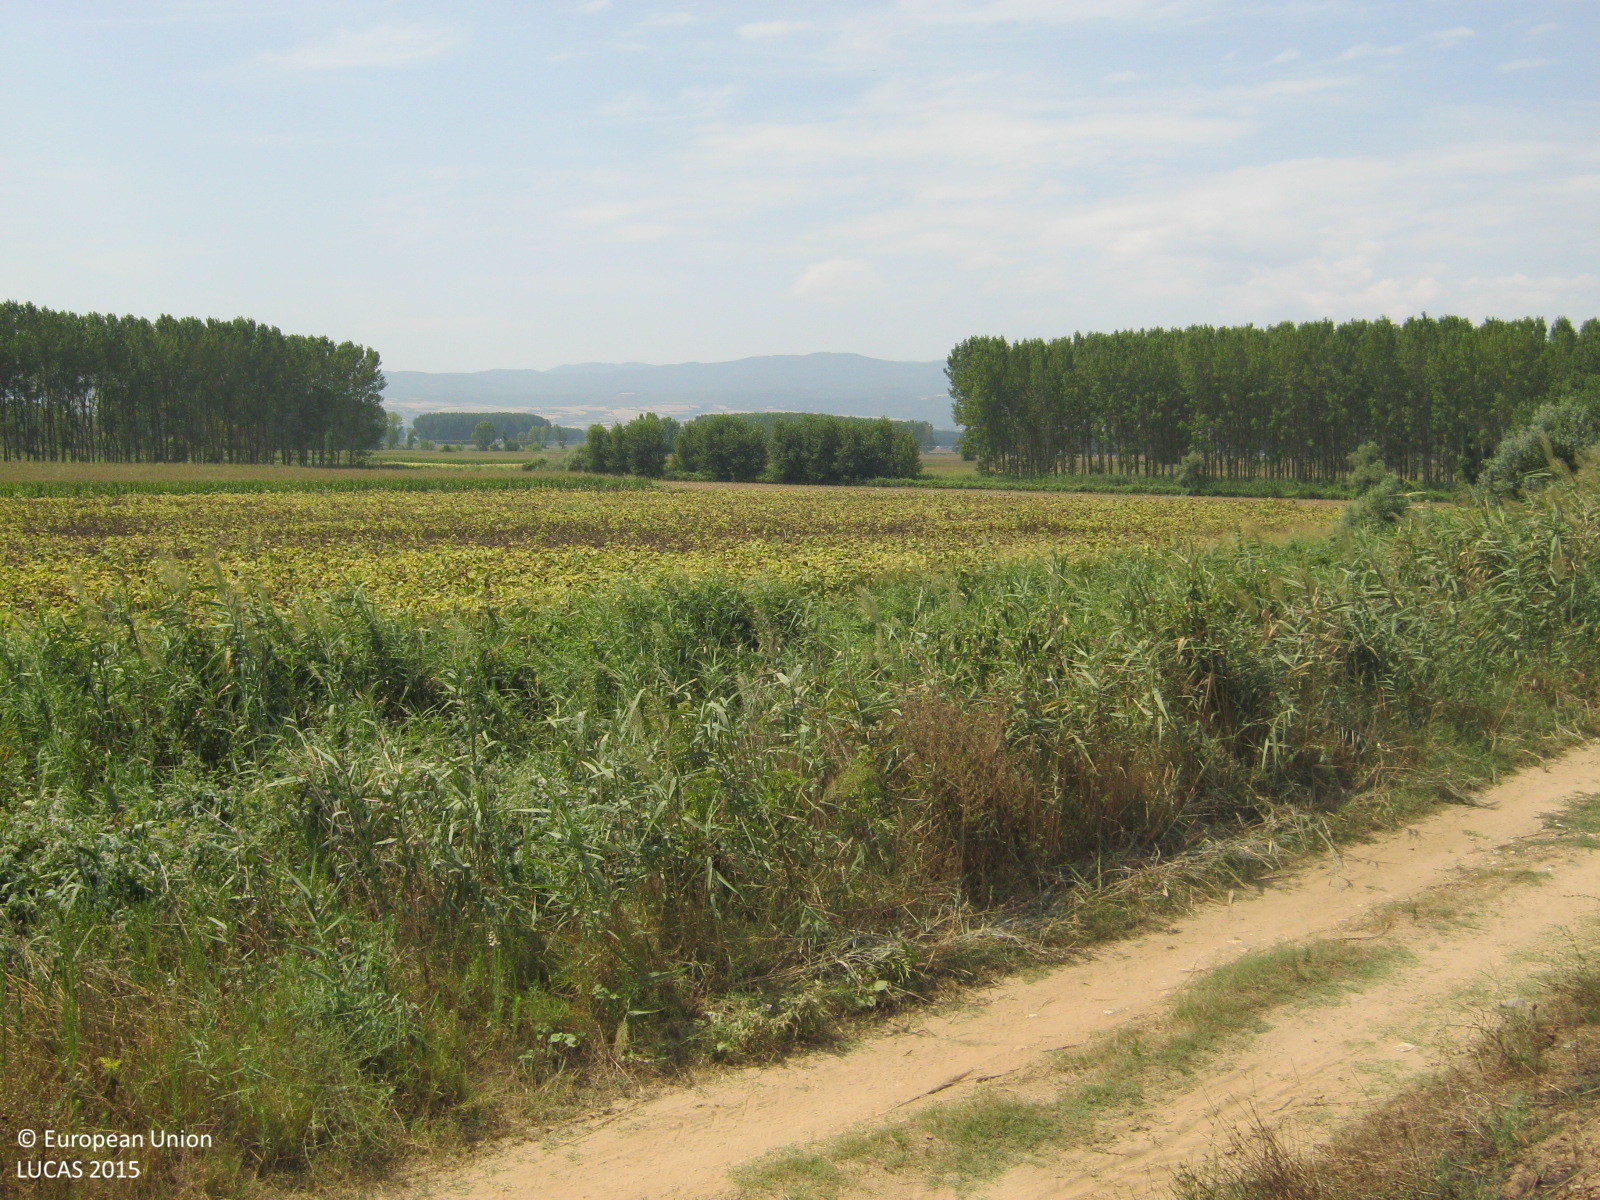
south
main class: Grassland
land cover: Grassland without tree/shrub cover
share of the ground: > 75 %
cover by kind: herbaceous plants 90 %, unconsolidated bare surface 10 %
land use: Semi-natural and natural areas not in use
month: August
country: GR
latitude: 40.9828
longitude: 23.4600
